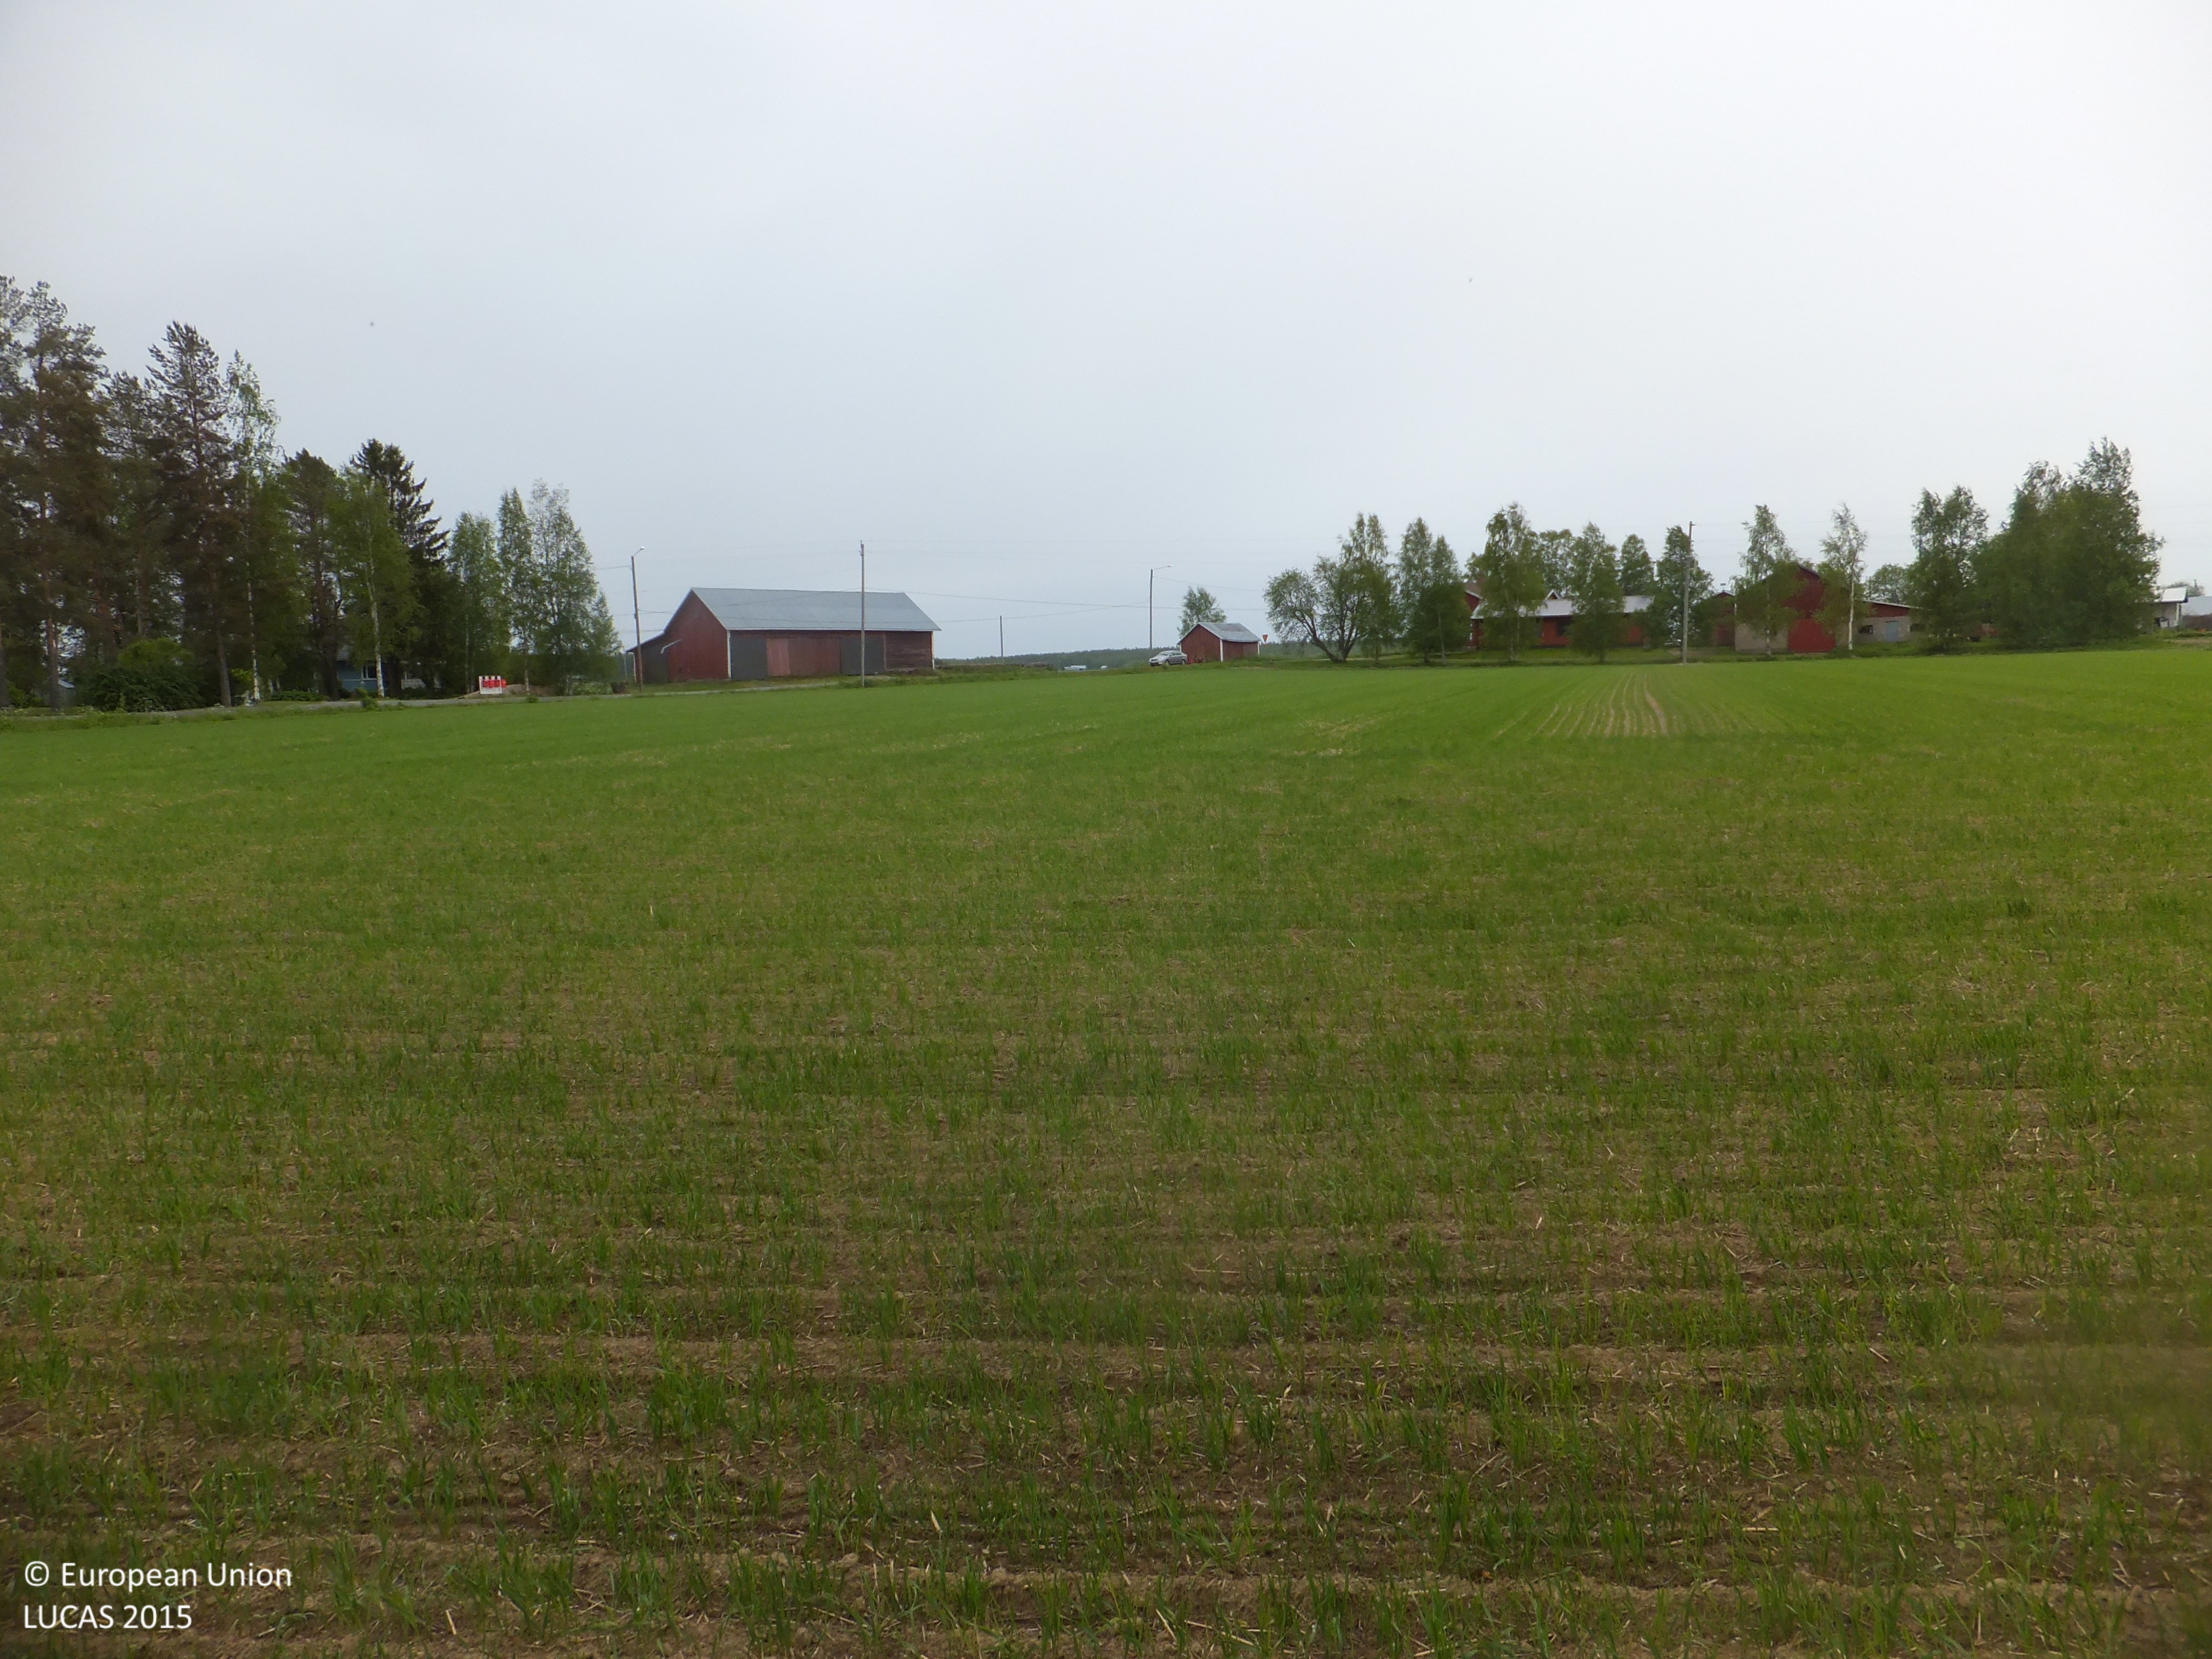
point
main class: Cropland
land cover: Common wheat
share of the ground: 10 - 25 %
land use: Agriculture (excluding fallow land and kitchen gardens)
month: June
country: FI
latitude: 63.2300
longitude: 22.6485
